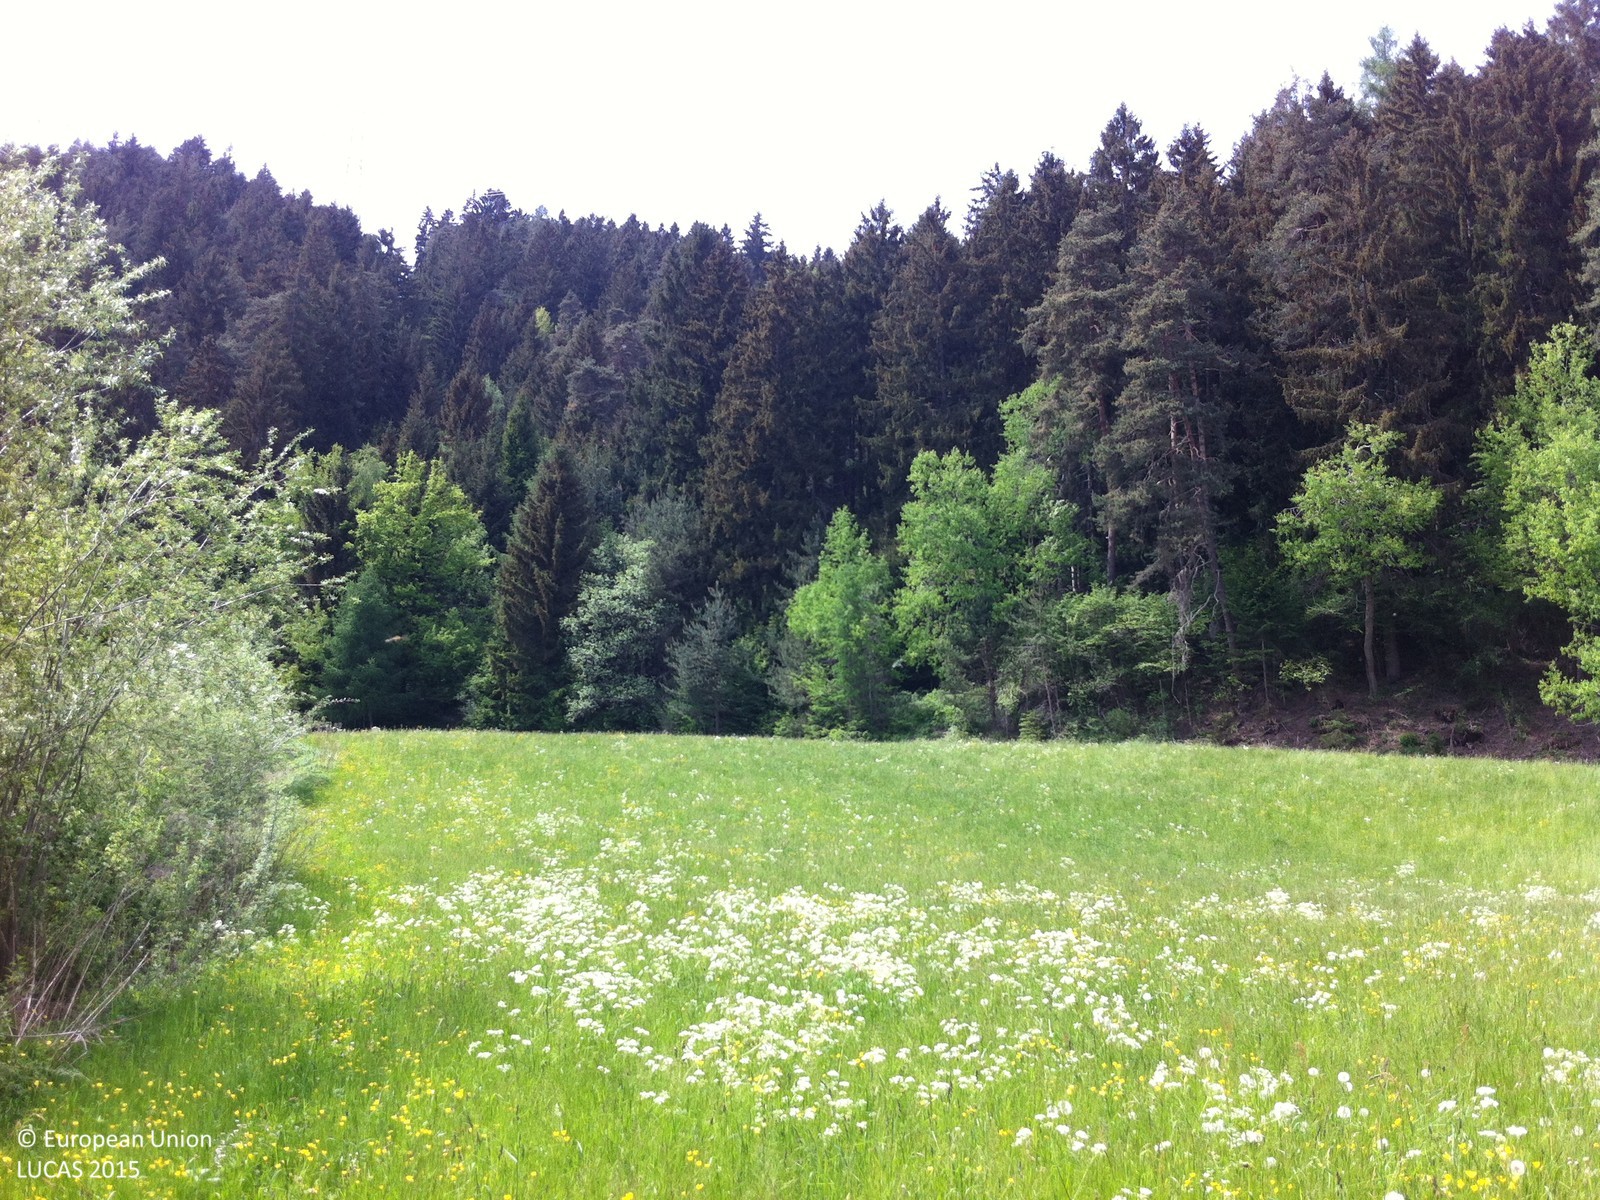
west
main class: Grassland
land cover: Grassland without tree/shrub cover
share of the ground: > 75 %
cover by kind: herbaceous plants 100 %
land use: Agriculture (excluding fallow land and kitchen gardens)
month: May
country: AT
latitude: 47.2437
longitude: 11.3067
